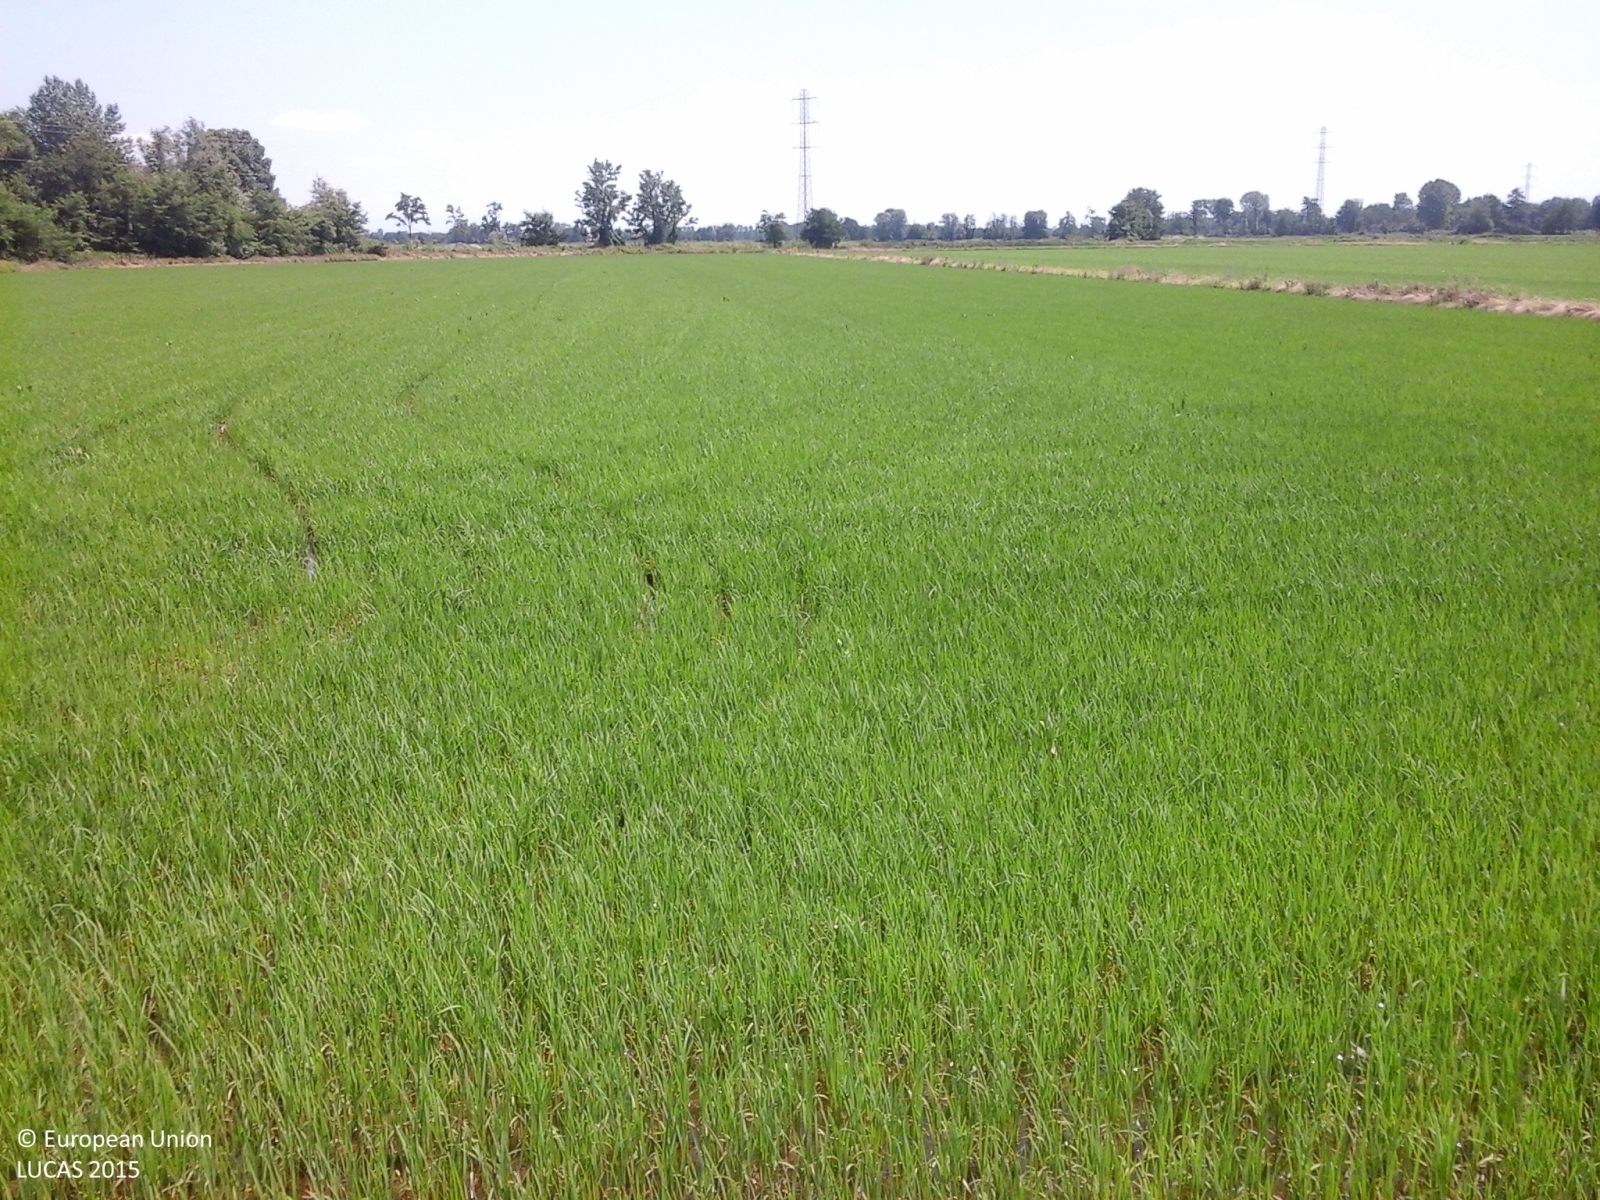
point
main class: Cropland
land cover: Rice
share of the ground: > 75 %
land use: Agriculture (excluding fallow land and kitchen gardens)
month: June
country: IT
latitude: 45.3533
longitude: 8.7895
